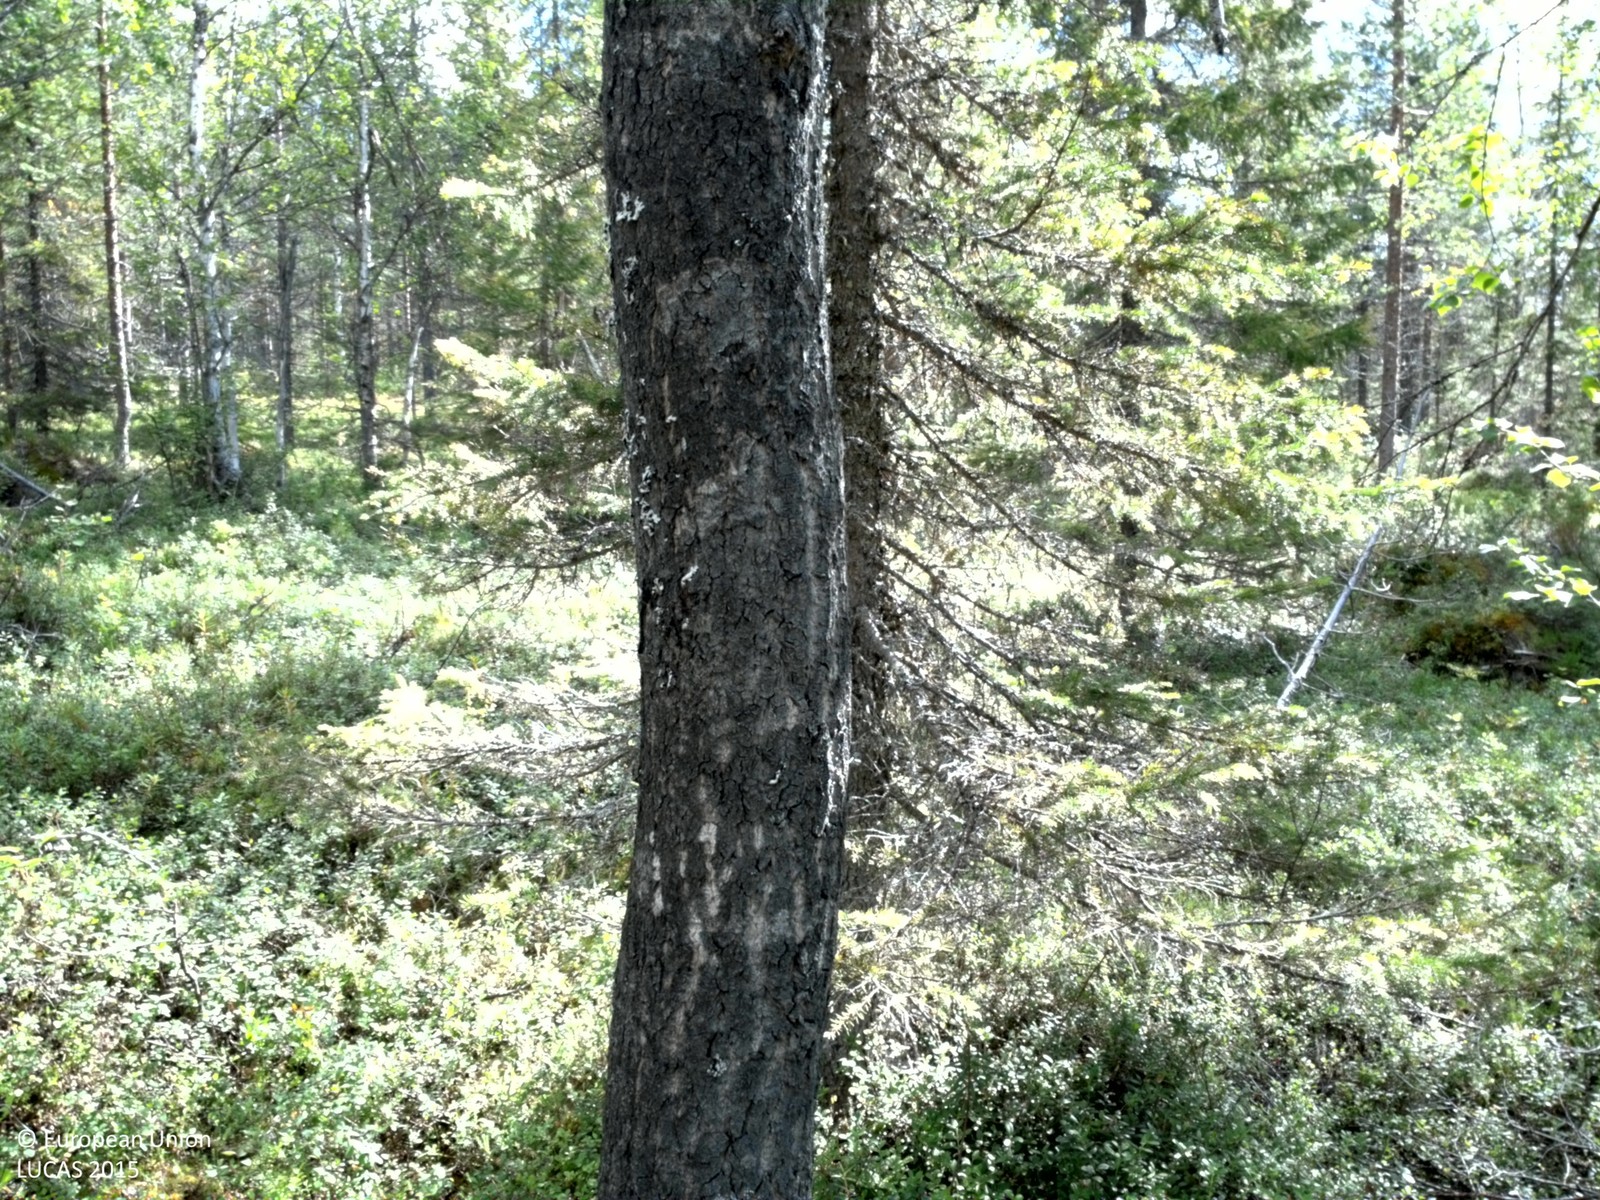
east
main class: Woodland
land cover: Pine dominated coniferous woodland
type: boreal forest
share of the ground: 25 - 50 %
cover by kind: shrubs 65 %, coniferous forest trees 30 %, broadleaved forest trees 5 %
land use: Forestry
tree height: > 5 m
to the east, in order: Pine dominated coniferous woodland; Shrubland without tree cover; Pine dominated coniferous woodland; Shrubland with sparse tree cover; Pine dominated coniferous woodland
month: August
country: SE
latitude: 66.1716
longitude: 22.3298
